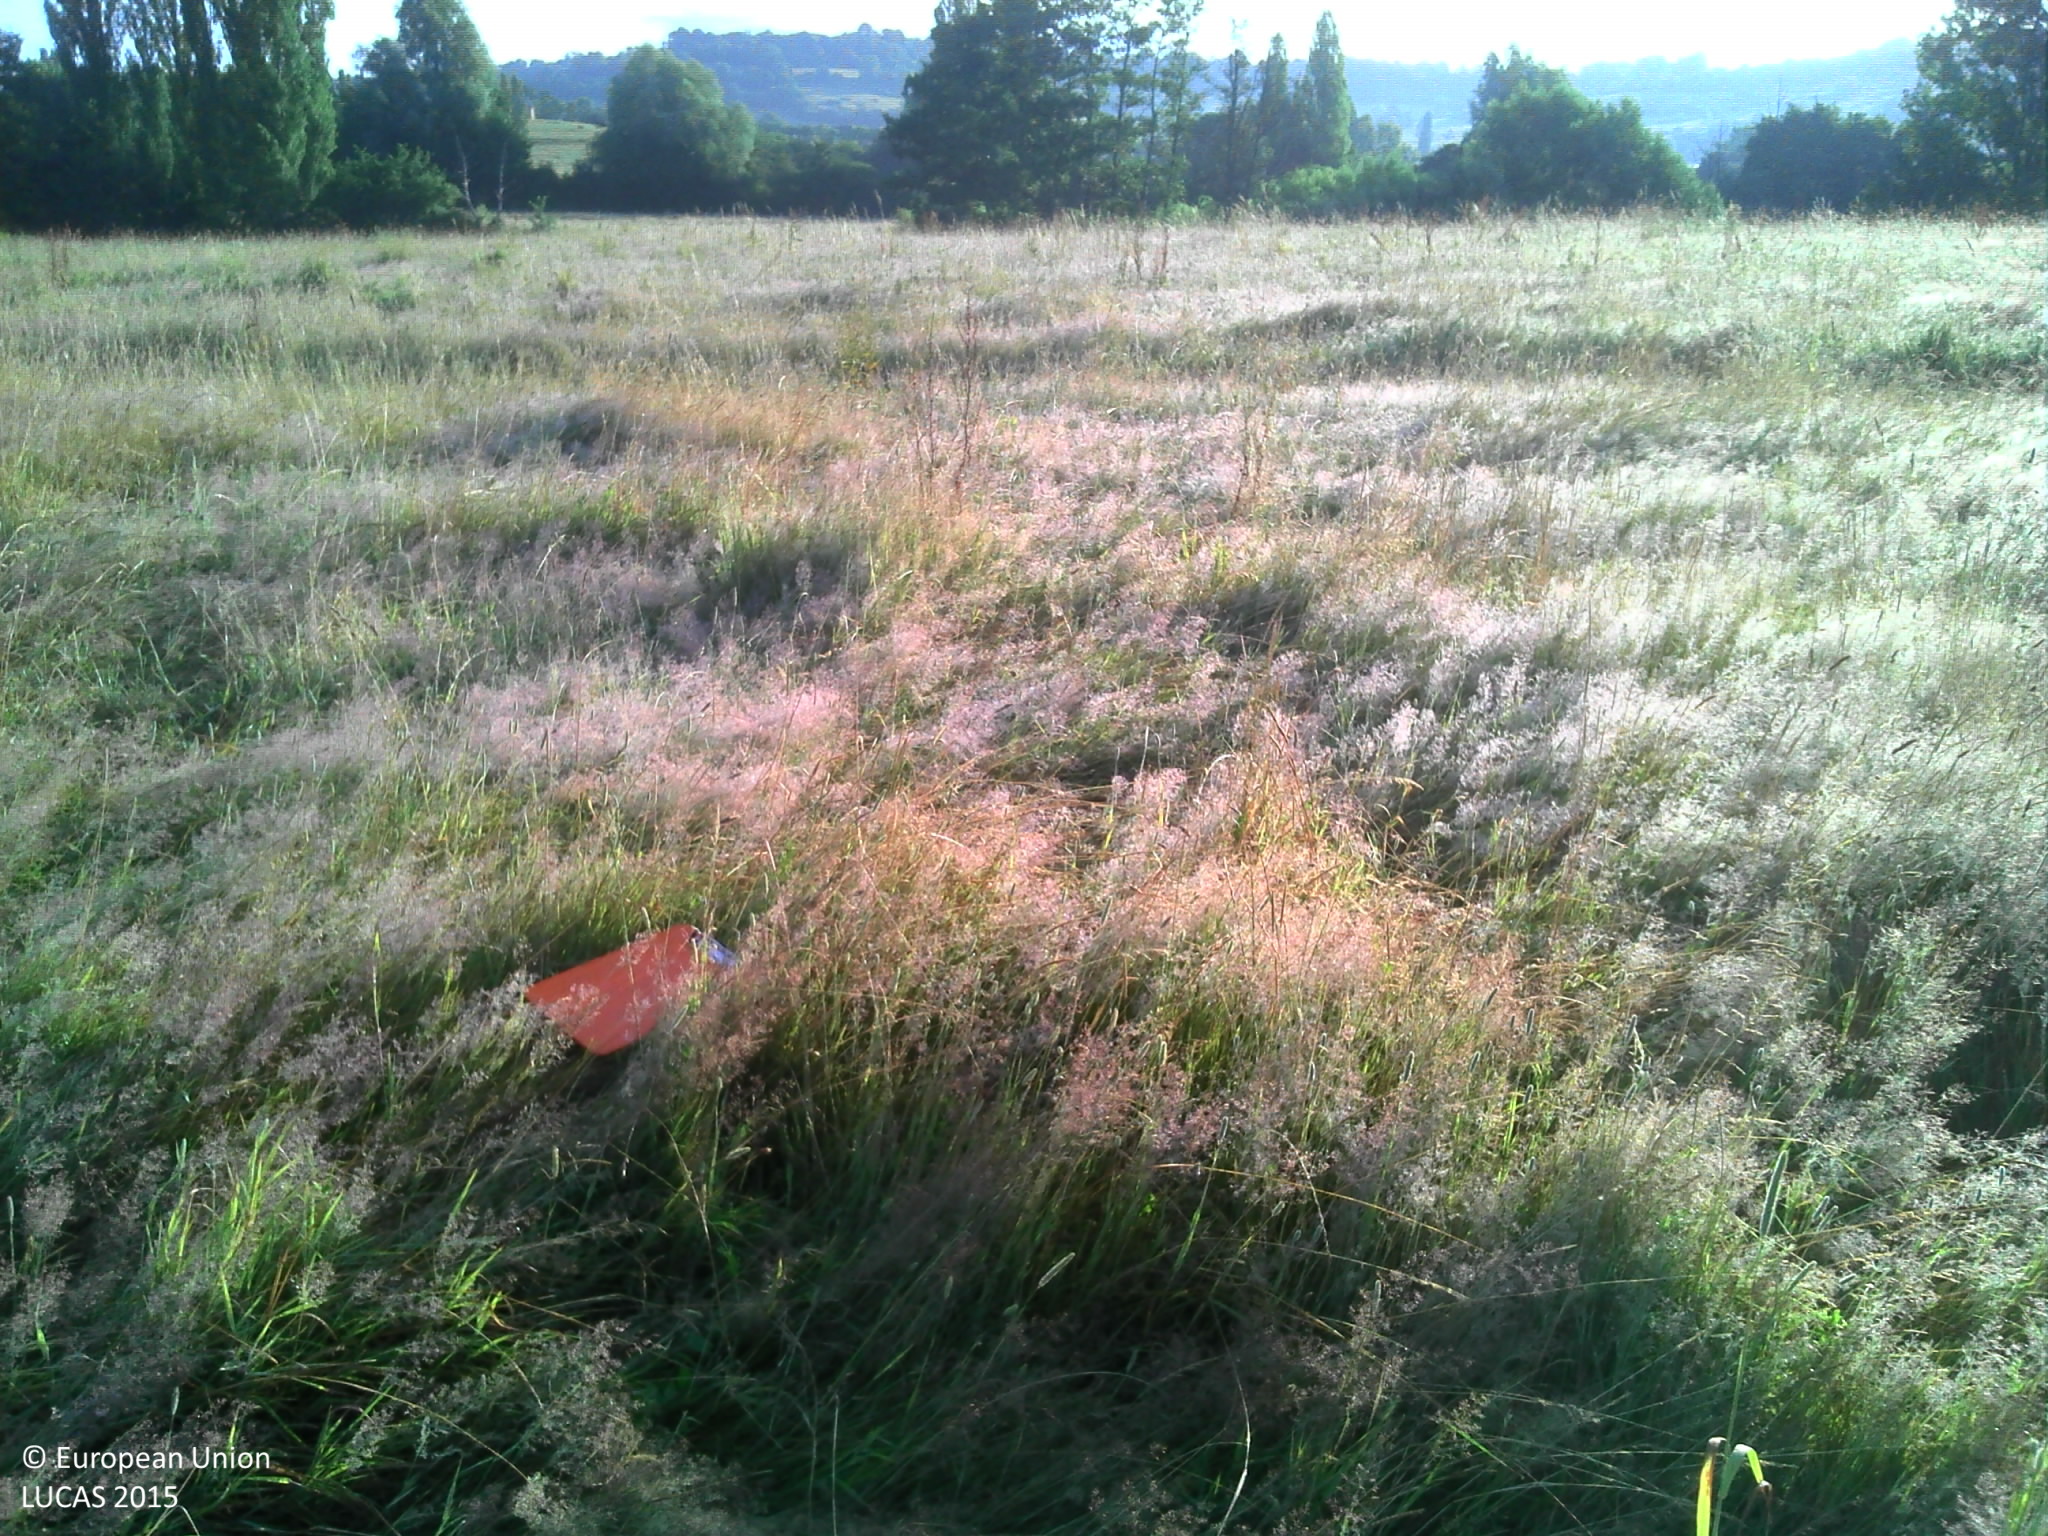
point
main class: Grassland
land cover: Grassland without tree/shrub cover
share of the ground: > 75 %
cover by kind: herbaceous plants 100 %
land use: Agriculture (excluding fallow land and kitchen gardens)
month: July
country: FR
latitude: 49.0793
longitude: 0.0715
